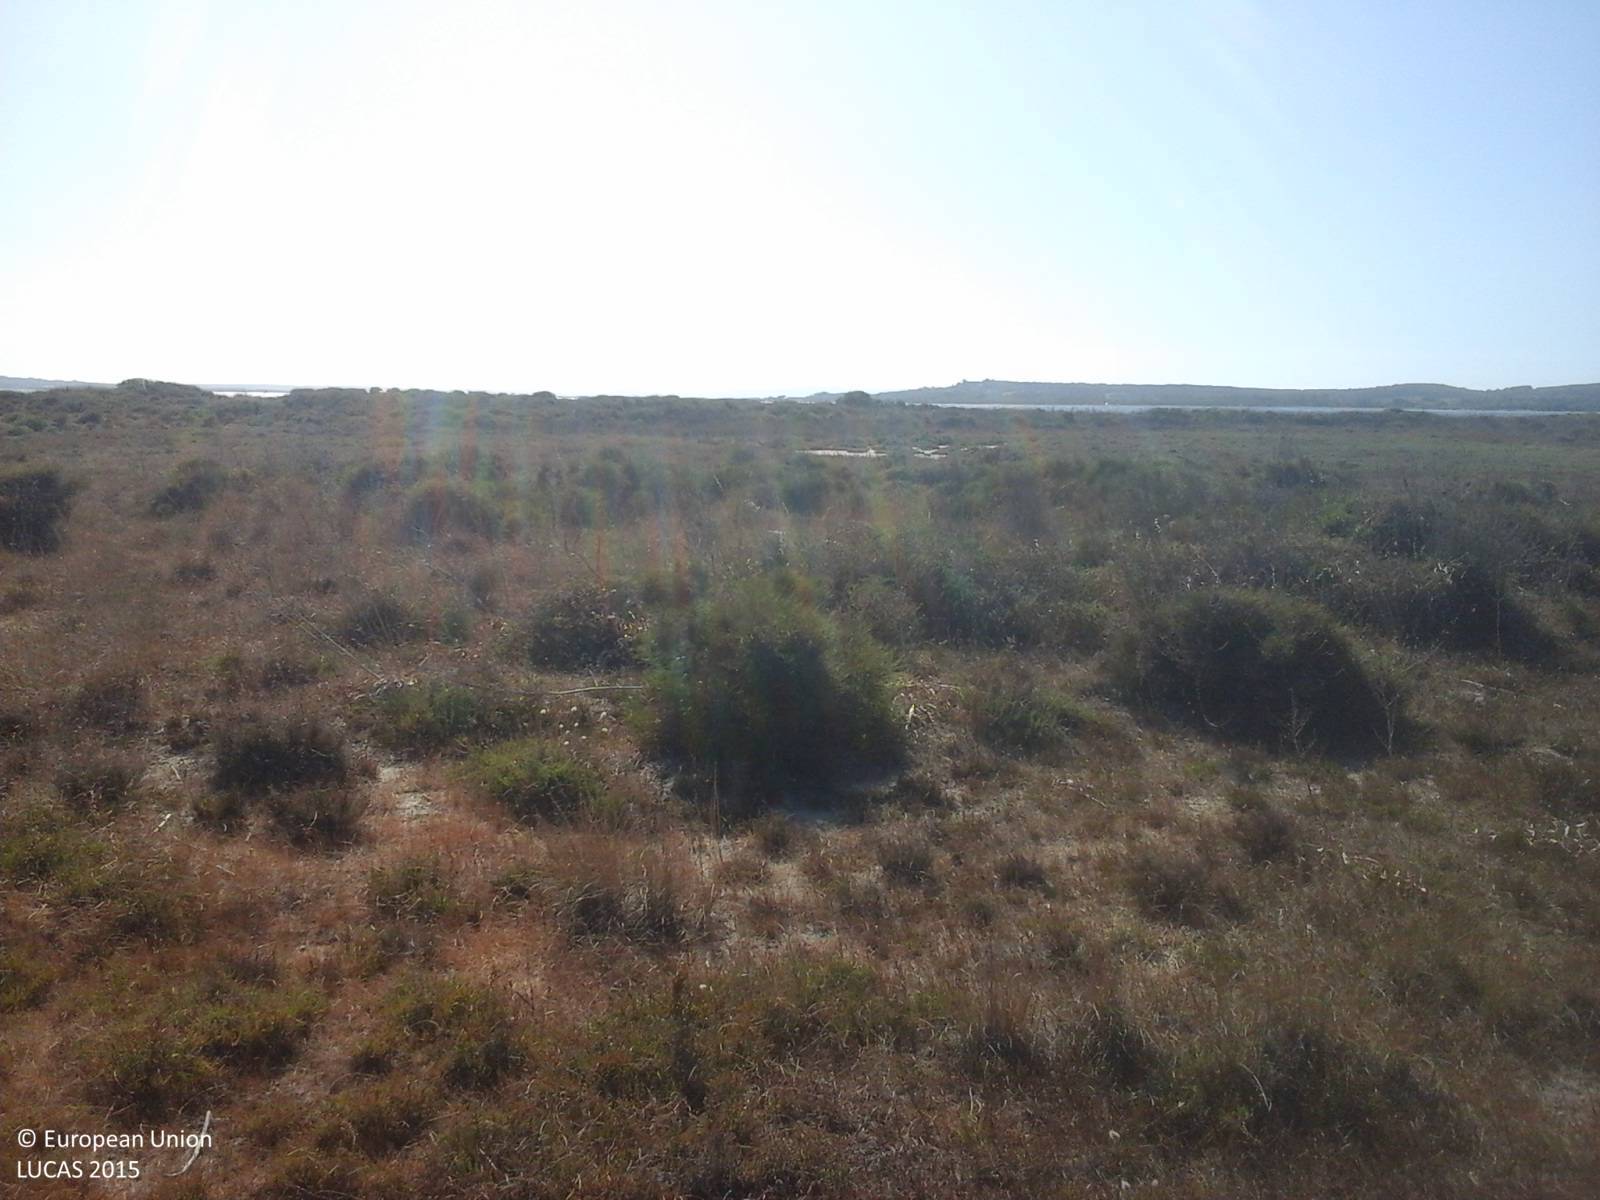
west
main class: Grassland
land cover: Grassland without tree/shrub cover
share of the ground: > 75 %
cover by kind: herbaceous plants 90 %, unconsolidated bare surface 10 %
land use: Semi-natural and natural areas not in use
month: July
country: IT
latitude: 39.1141
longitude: 8.4714
